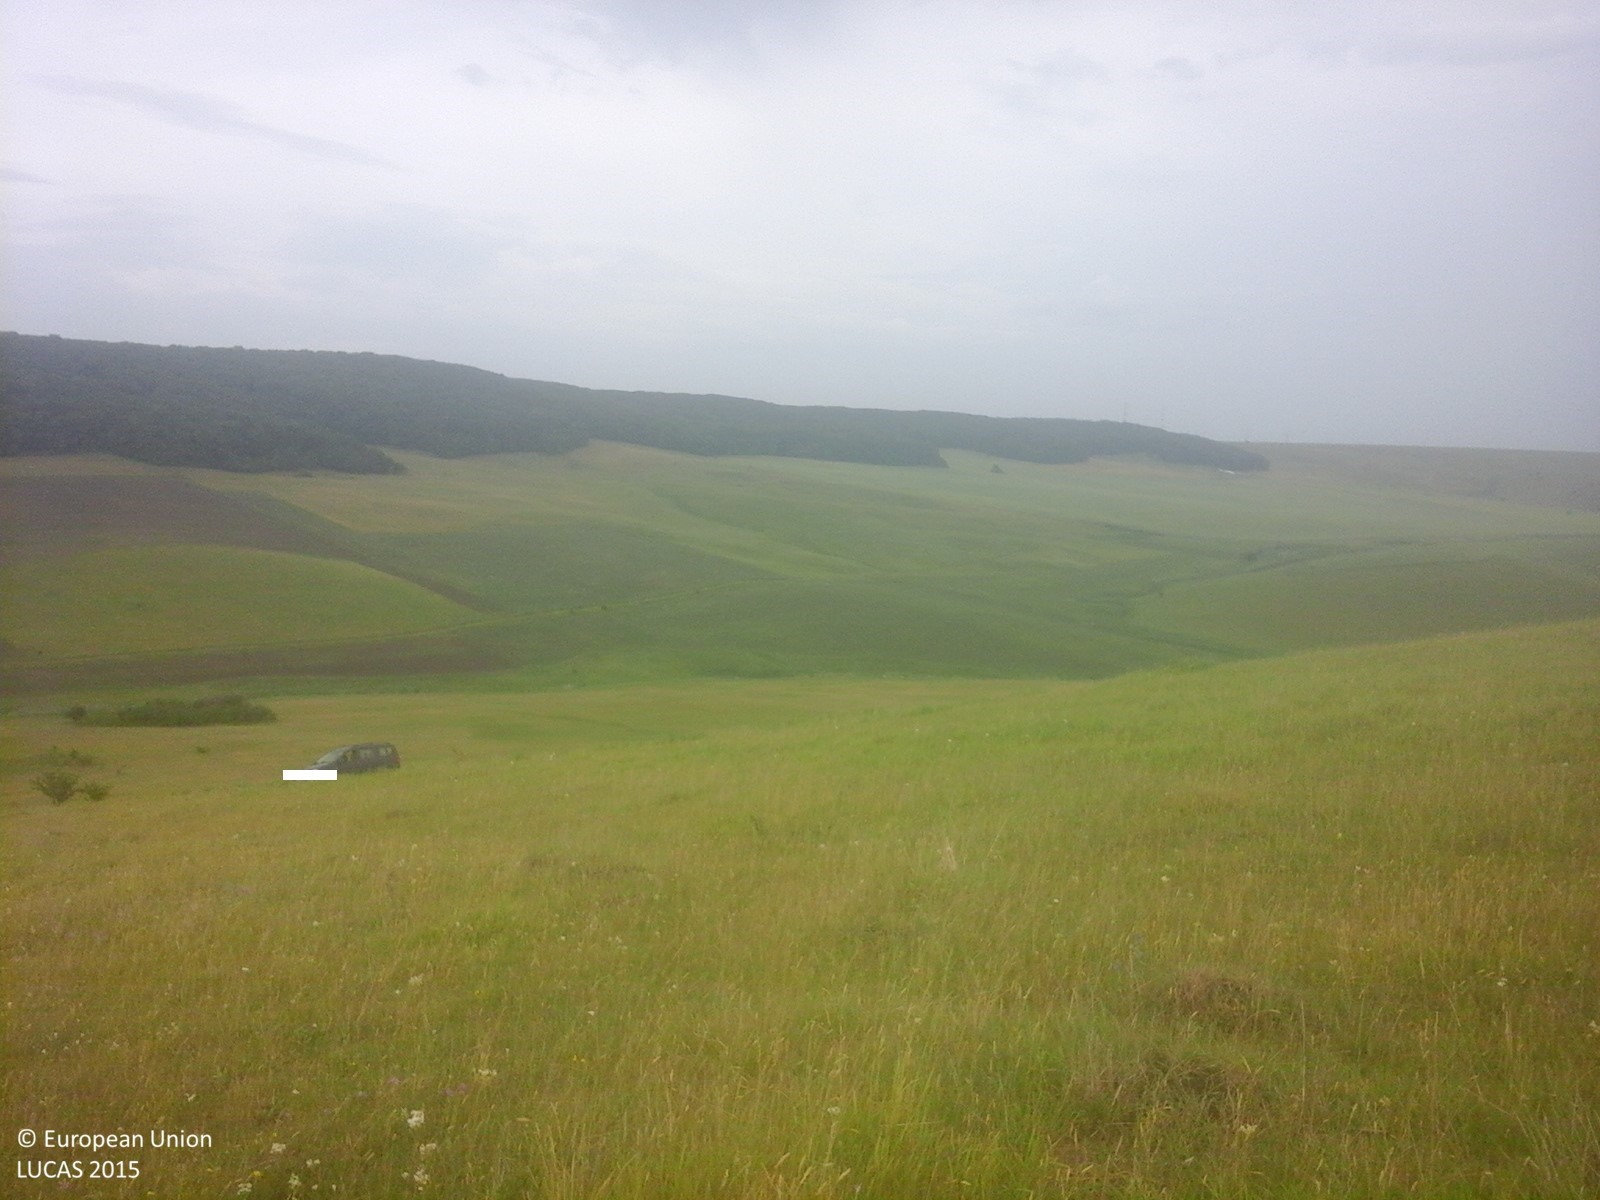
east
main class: Grassland
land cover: Grassland without tree/shrub cover
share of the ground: > 75 %
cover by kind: herbaceous plants 100 %
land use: Agriculture (excluding fallow land and kitchen gardens)
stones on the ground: < 10 %
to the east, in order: Grassland without tree/shrub cover
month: June
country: RO
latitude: 46.9669
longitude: 26.3929
